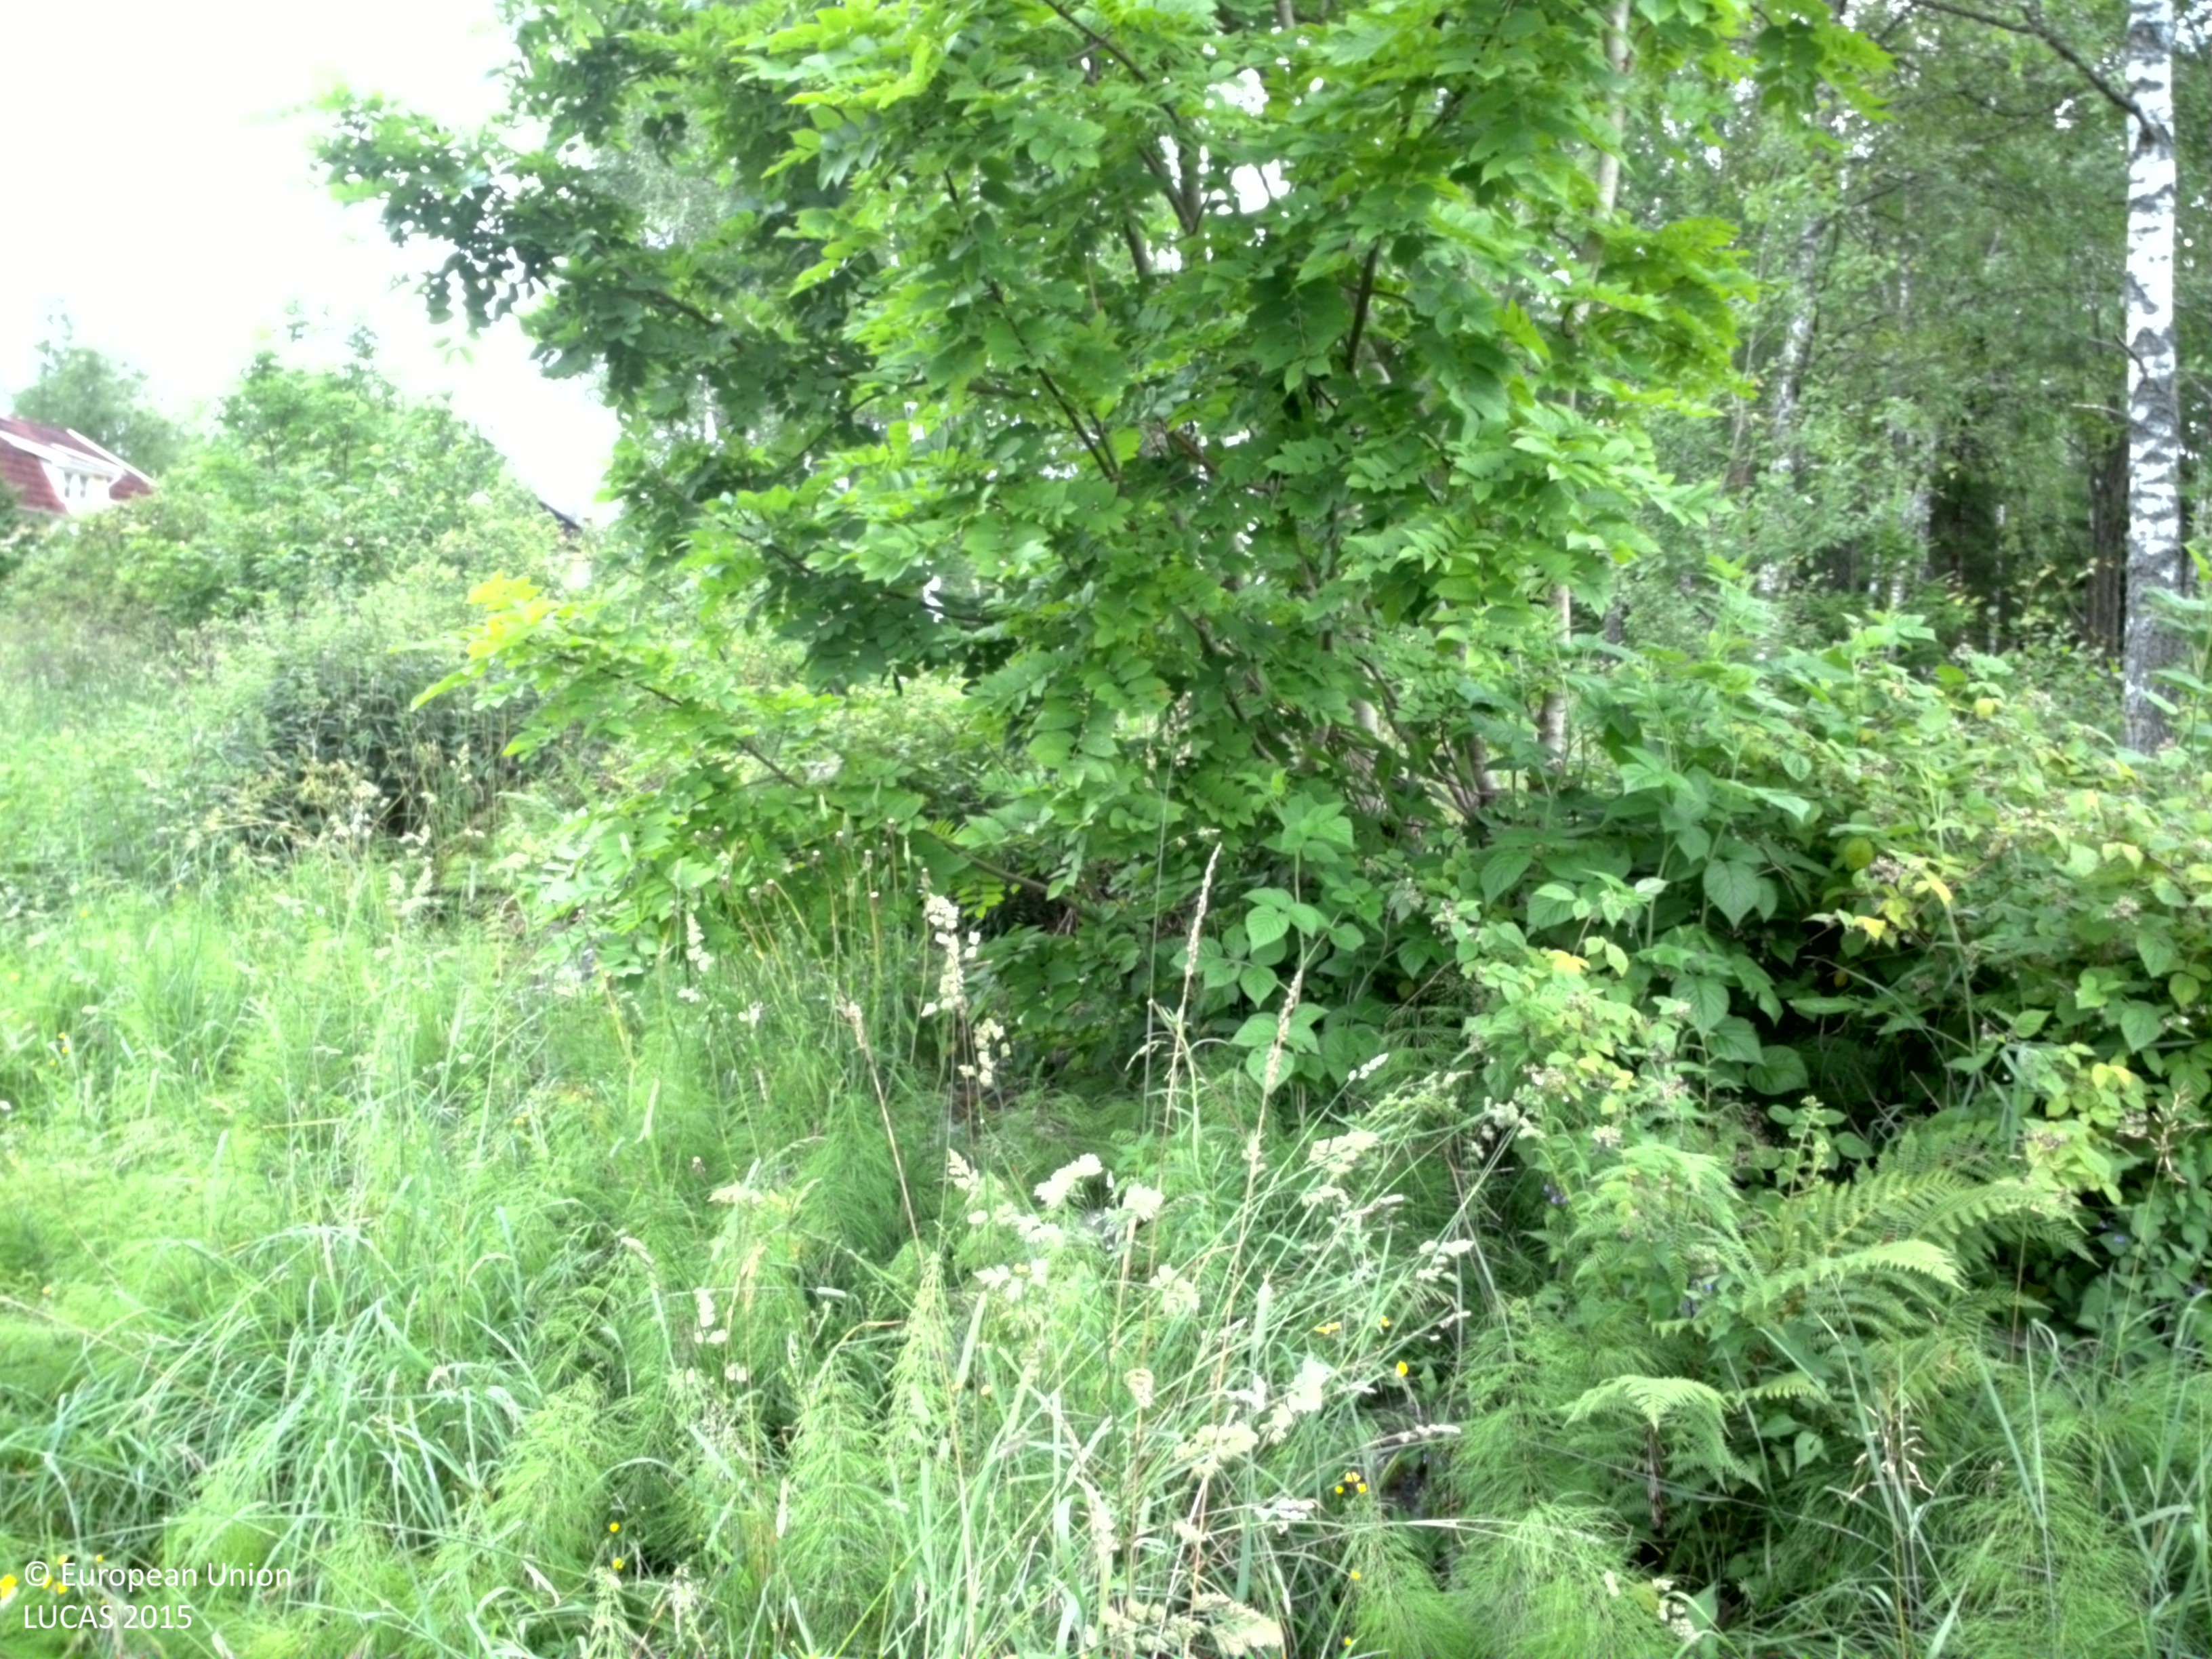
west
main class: Grassland
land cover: Grassland without tree/shrub cover
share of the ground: > 75 %
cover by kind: herbaceous plants 100 %
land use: Agriculture (excluding fallow land and kitchen gardens)
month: July
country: SE
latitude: 58.1424
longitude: 13.9862
